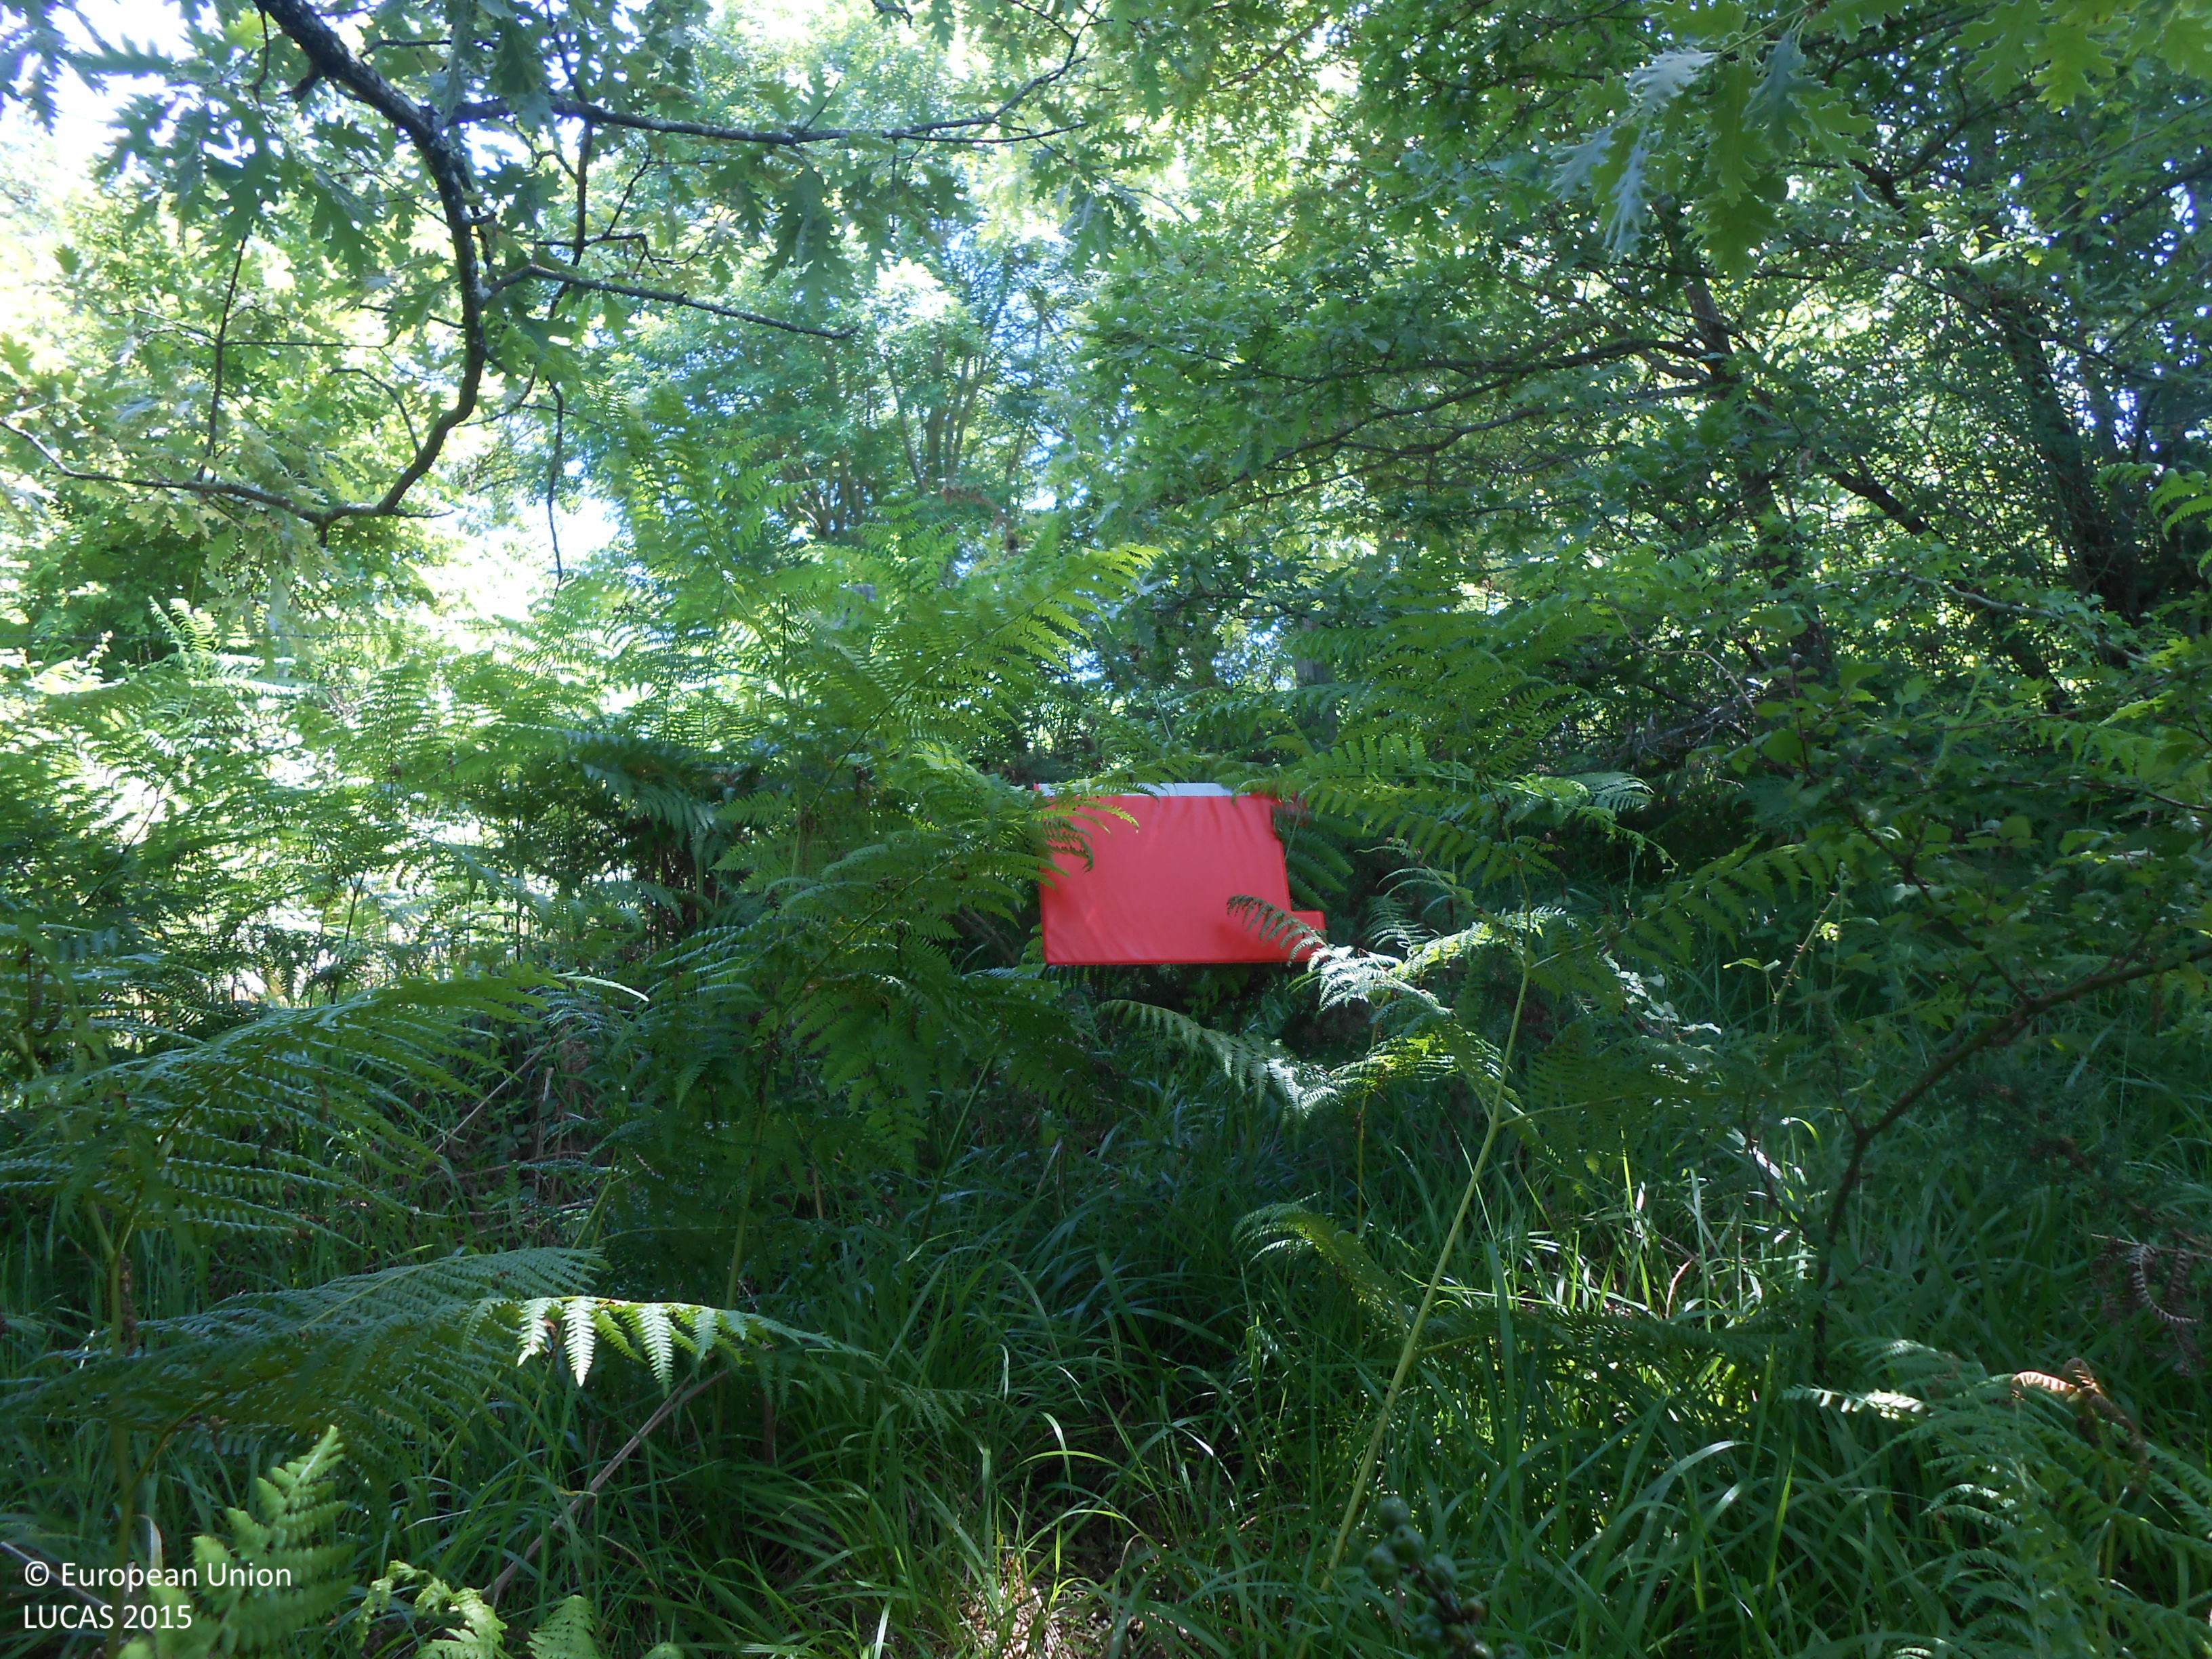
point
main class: Woodland
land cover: Broadleaved woodland
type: acidophilous oak and oak-birch forest
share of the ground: > 75 %
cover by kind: broadleaved forest trees 100 %
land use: Forestry
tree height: > 5 m
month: June
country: ES
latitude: 43.0112
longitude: -1.7093
